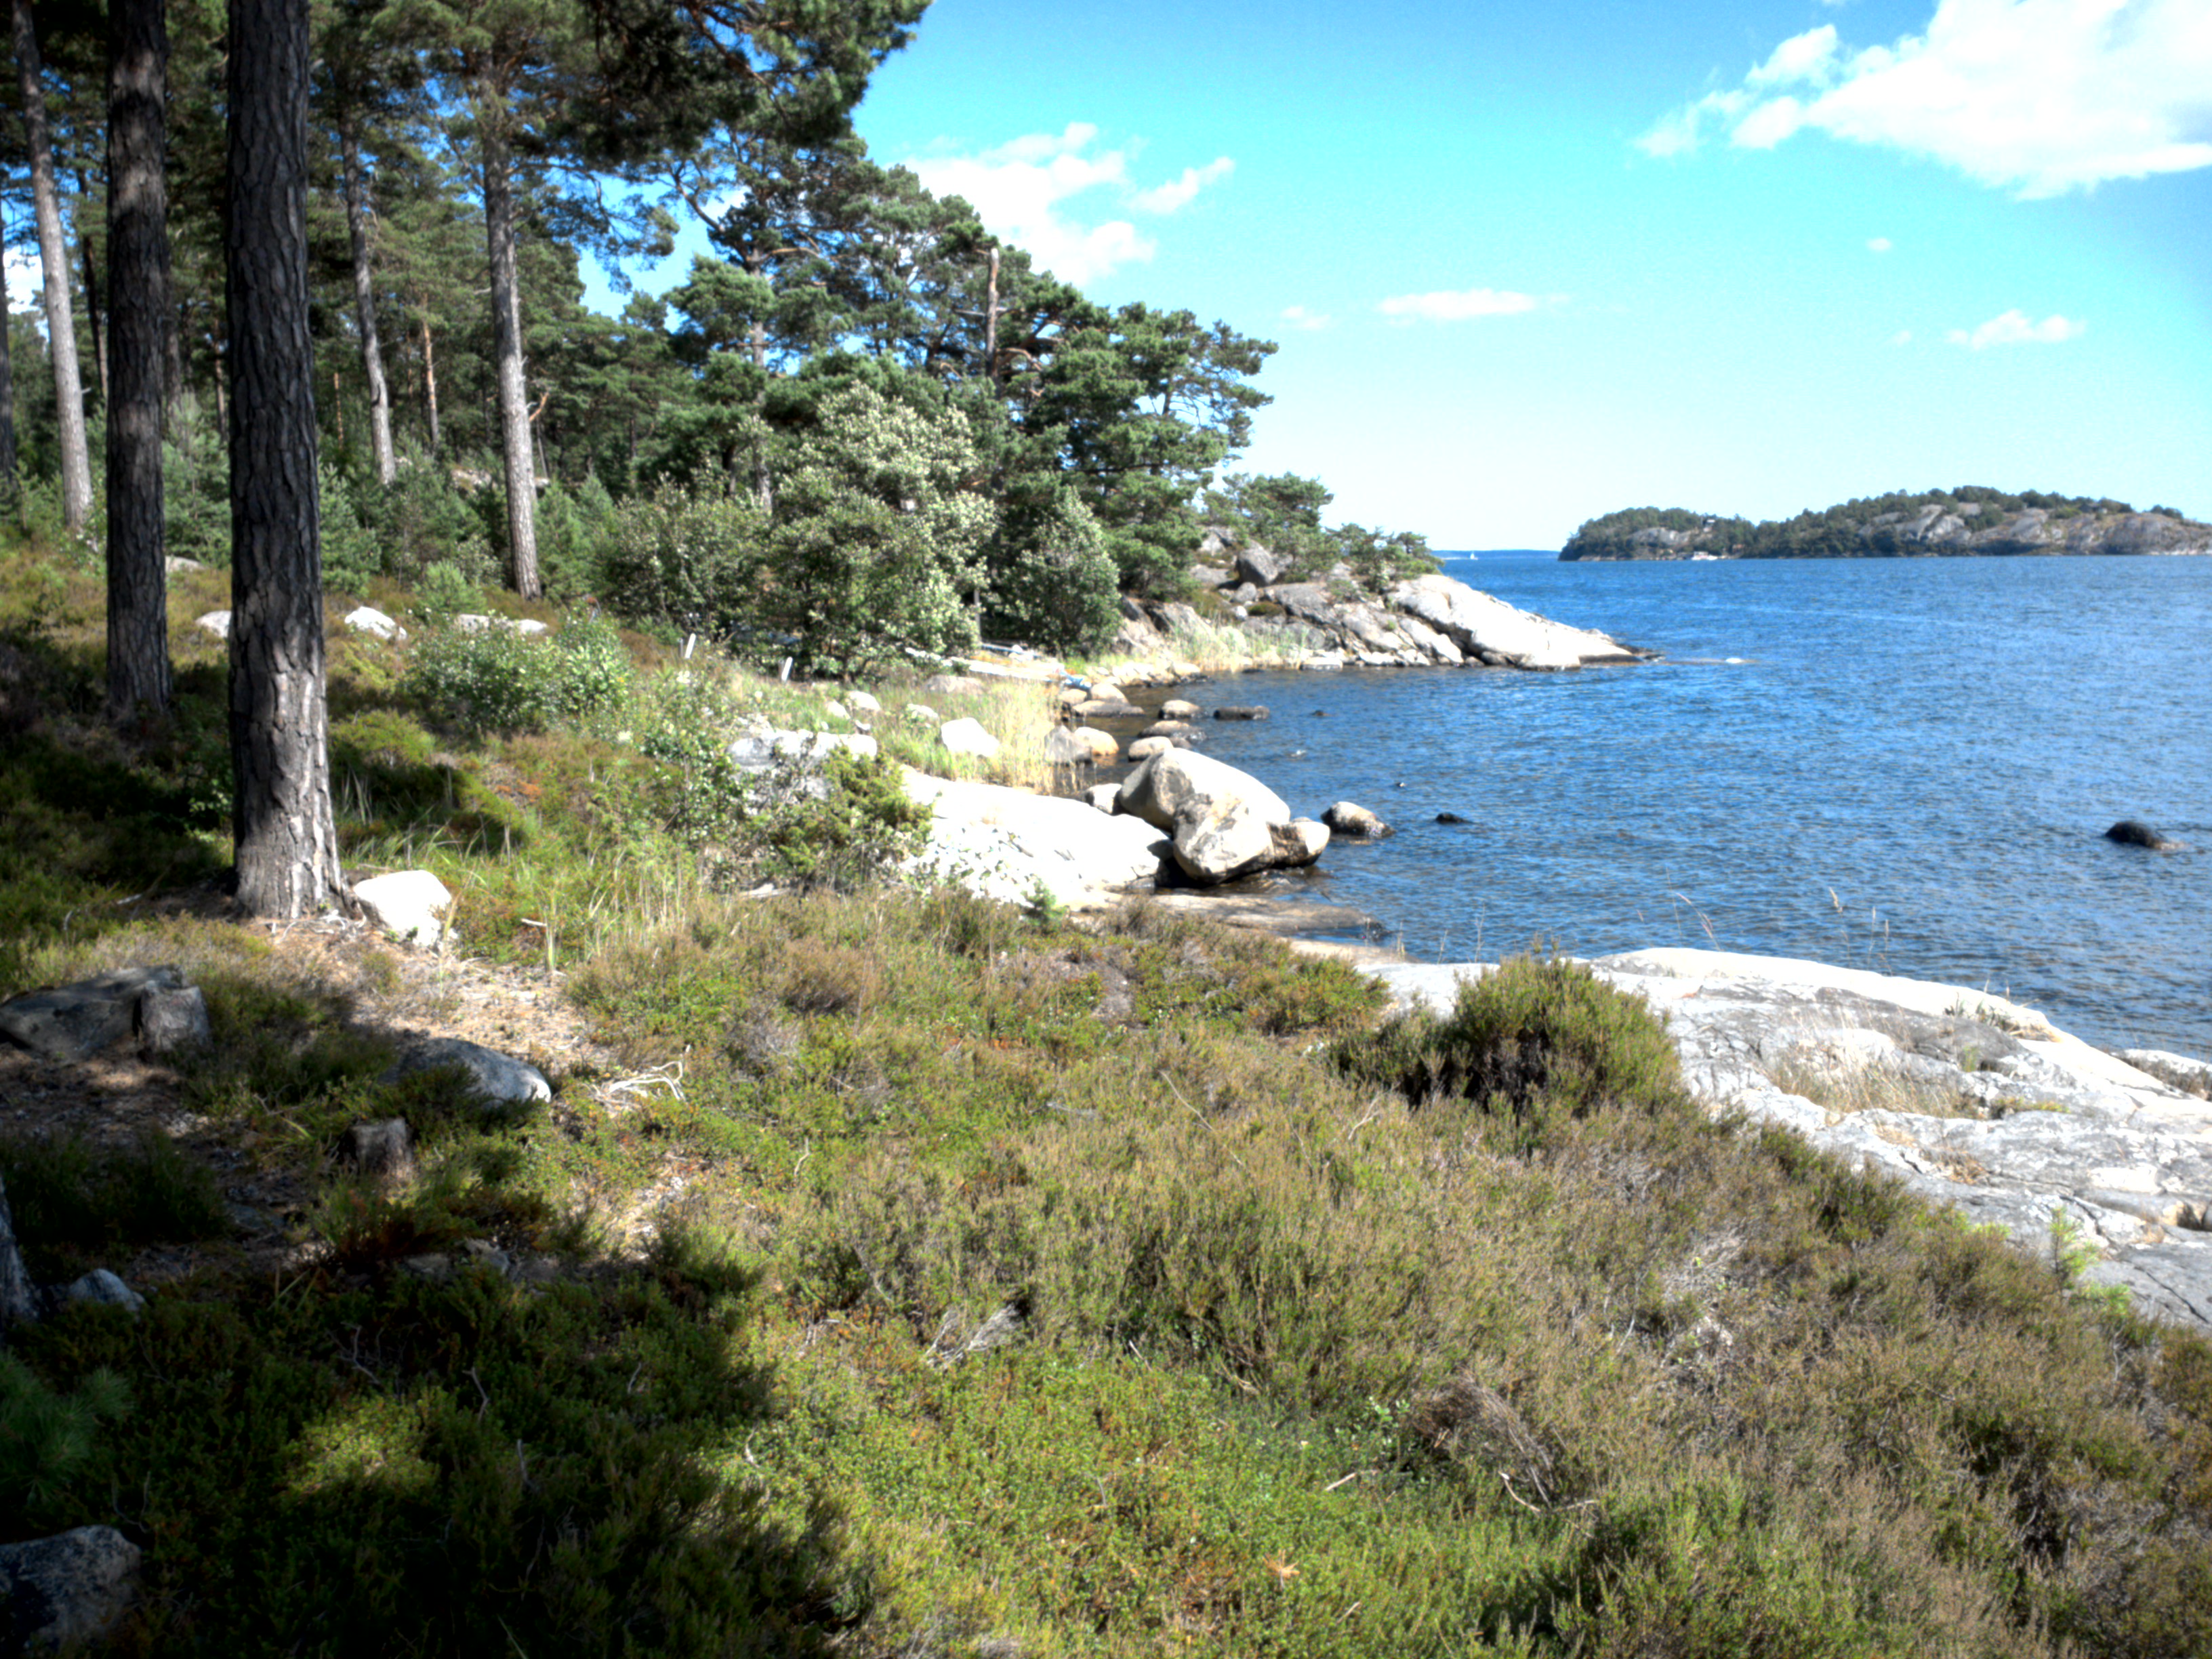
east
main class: Woodland
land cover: Pine dominated coniferous woodland
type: boreal forest
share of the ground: 25 - 50 %
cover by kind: coniferous forest trees 40 %, shrubs 40 %, lichens and mosses 20 %
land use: Amenities, museums, leisure
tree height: > 5 m
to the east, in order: Pine dominated coniferous woodland; Rocks and stones
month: July
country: SE
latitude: 59.0182
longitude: 18.2040
